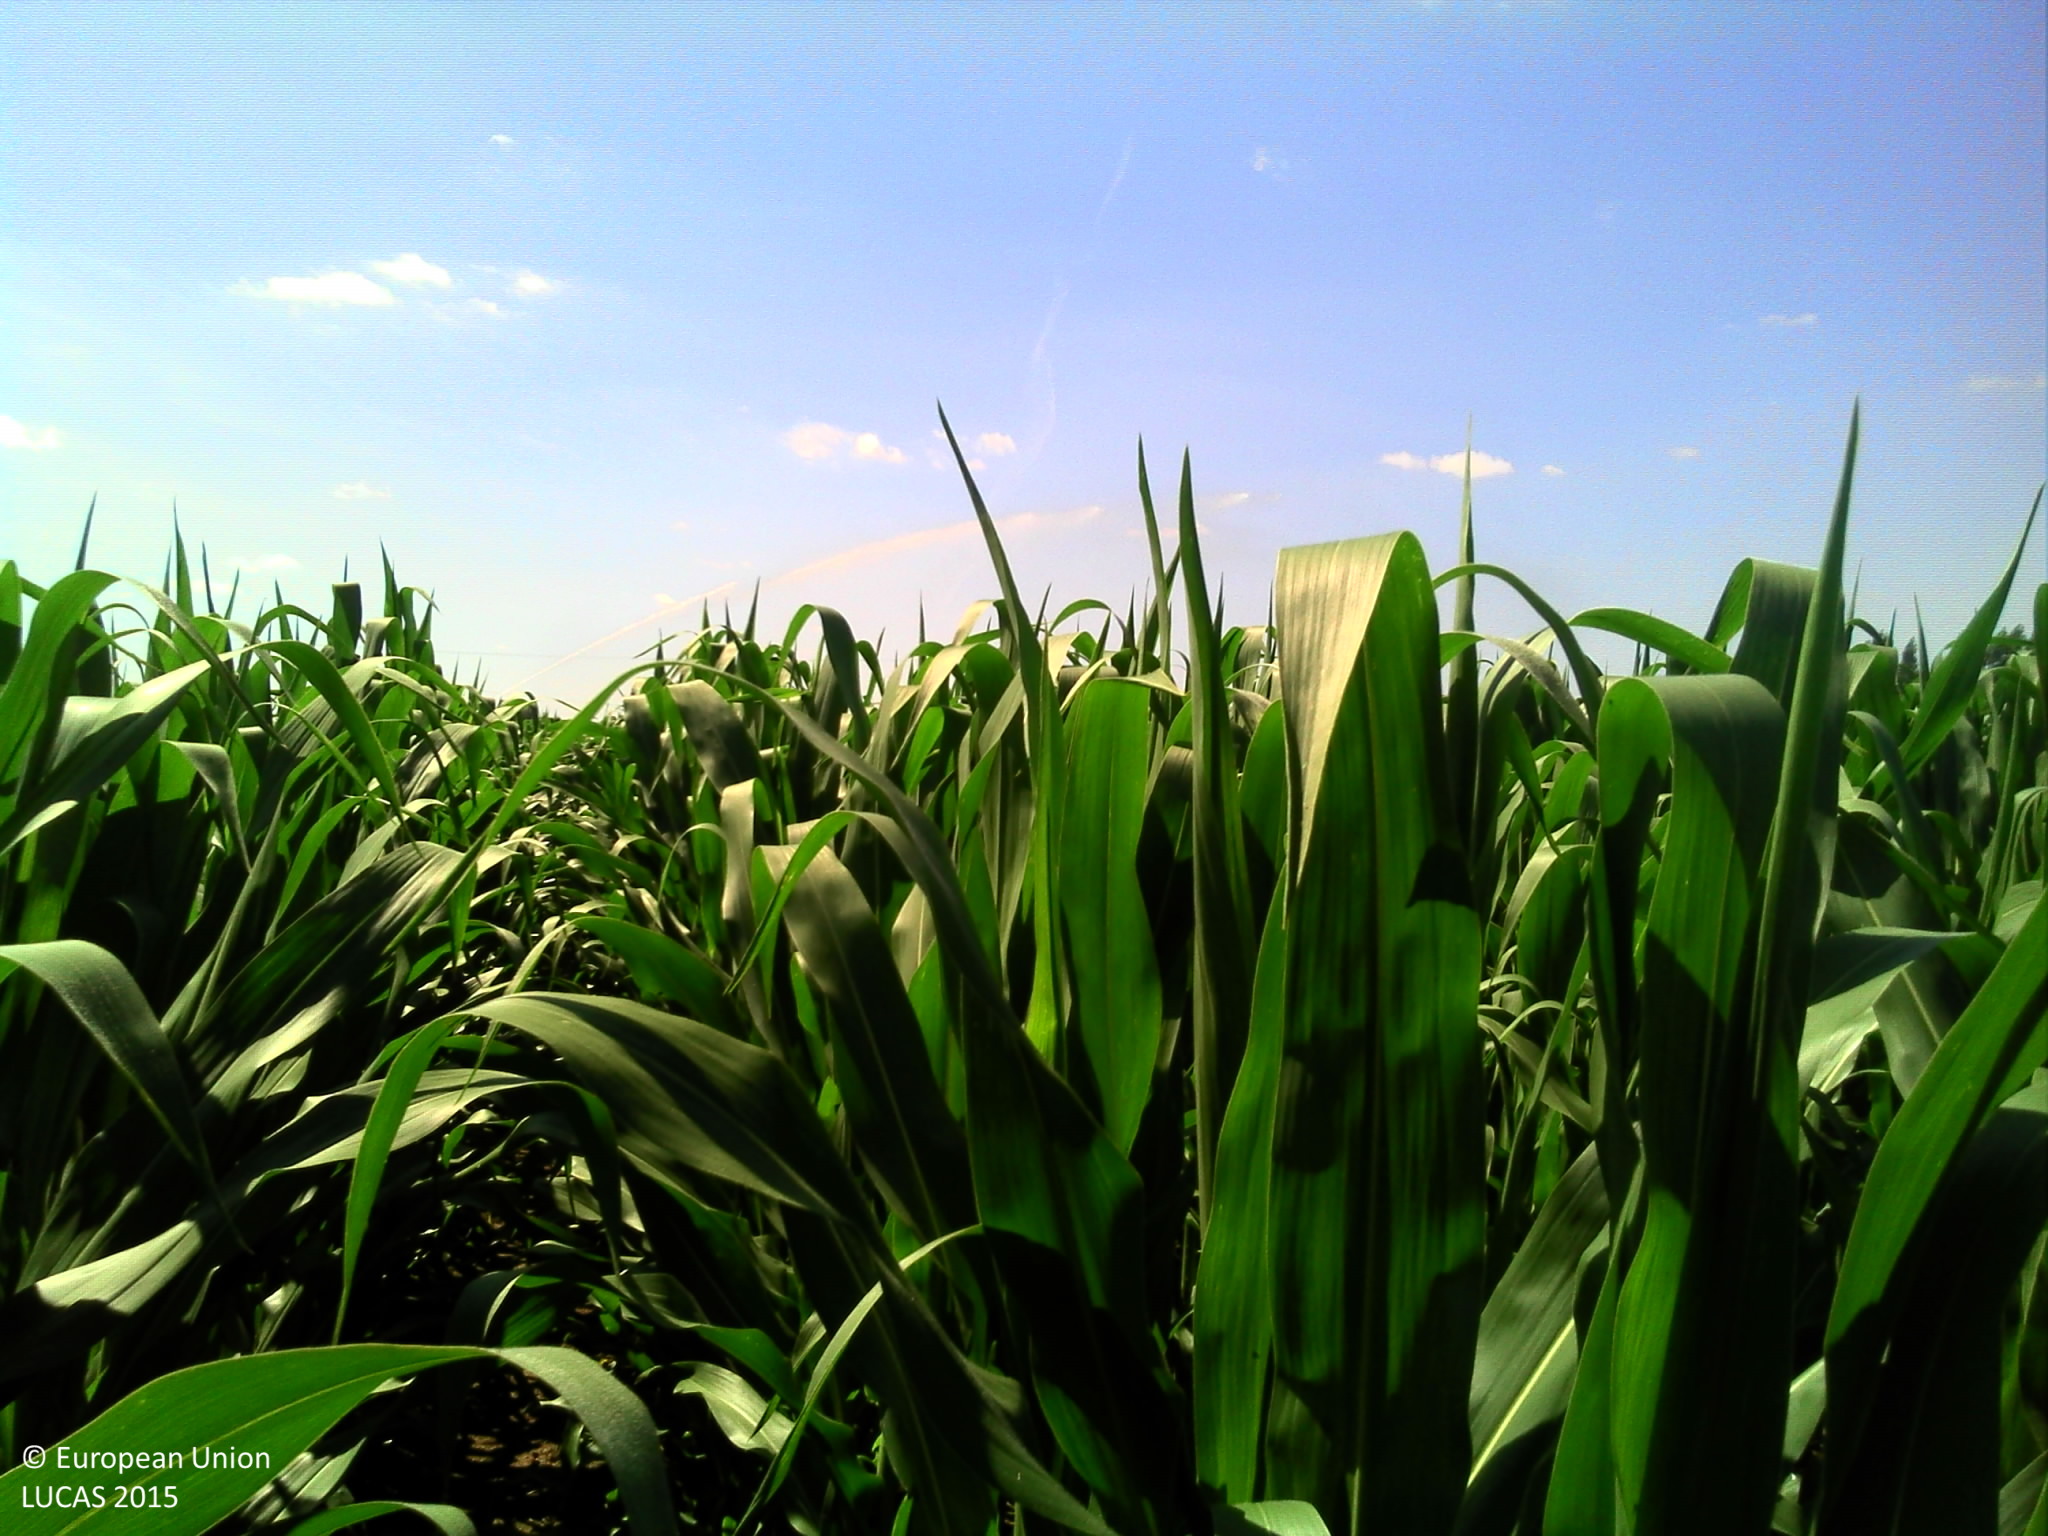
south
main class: Cropland
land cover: Maize
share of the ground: > 75 %
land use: Agriculture (excluding fallow land and kitchen gardens)
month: July
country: FR
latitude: 48.0229
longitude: 3.0610
